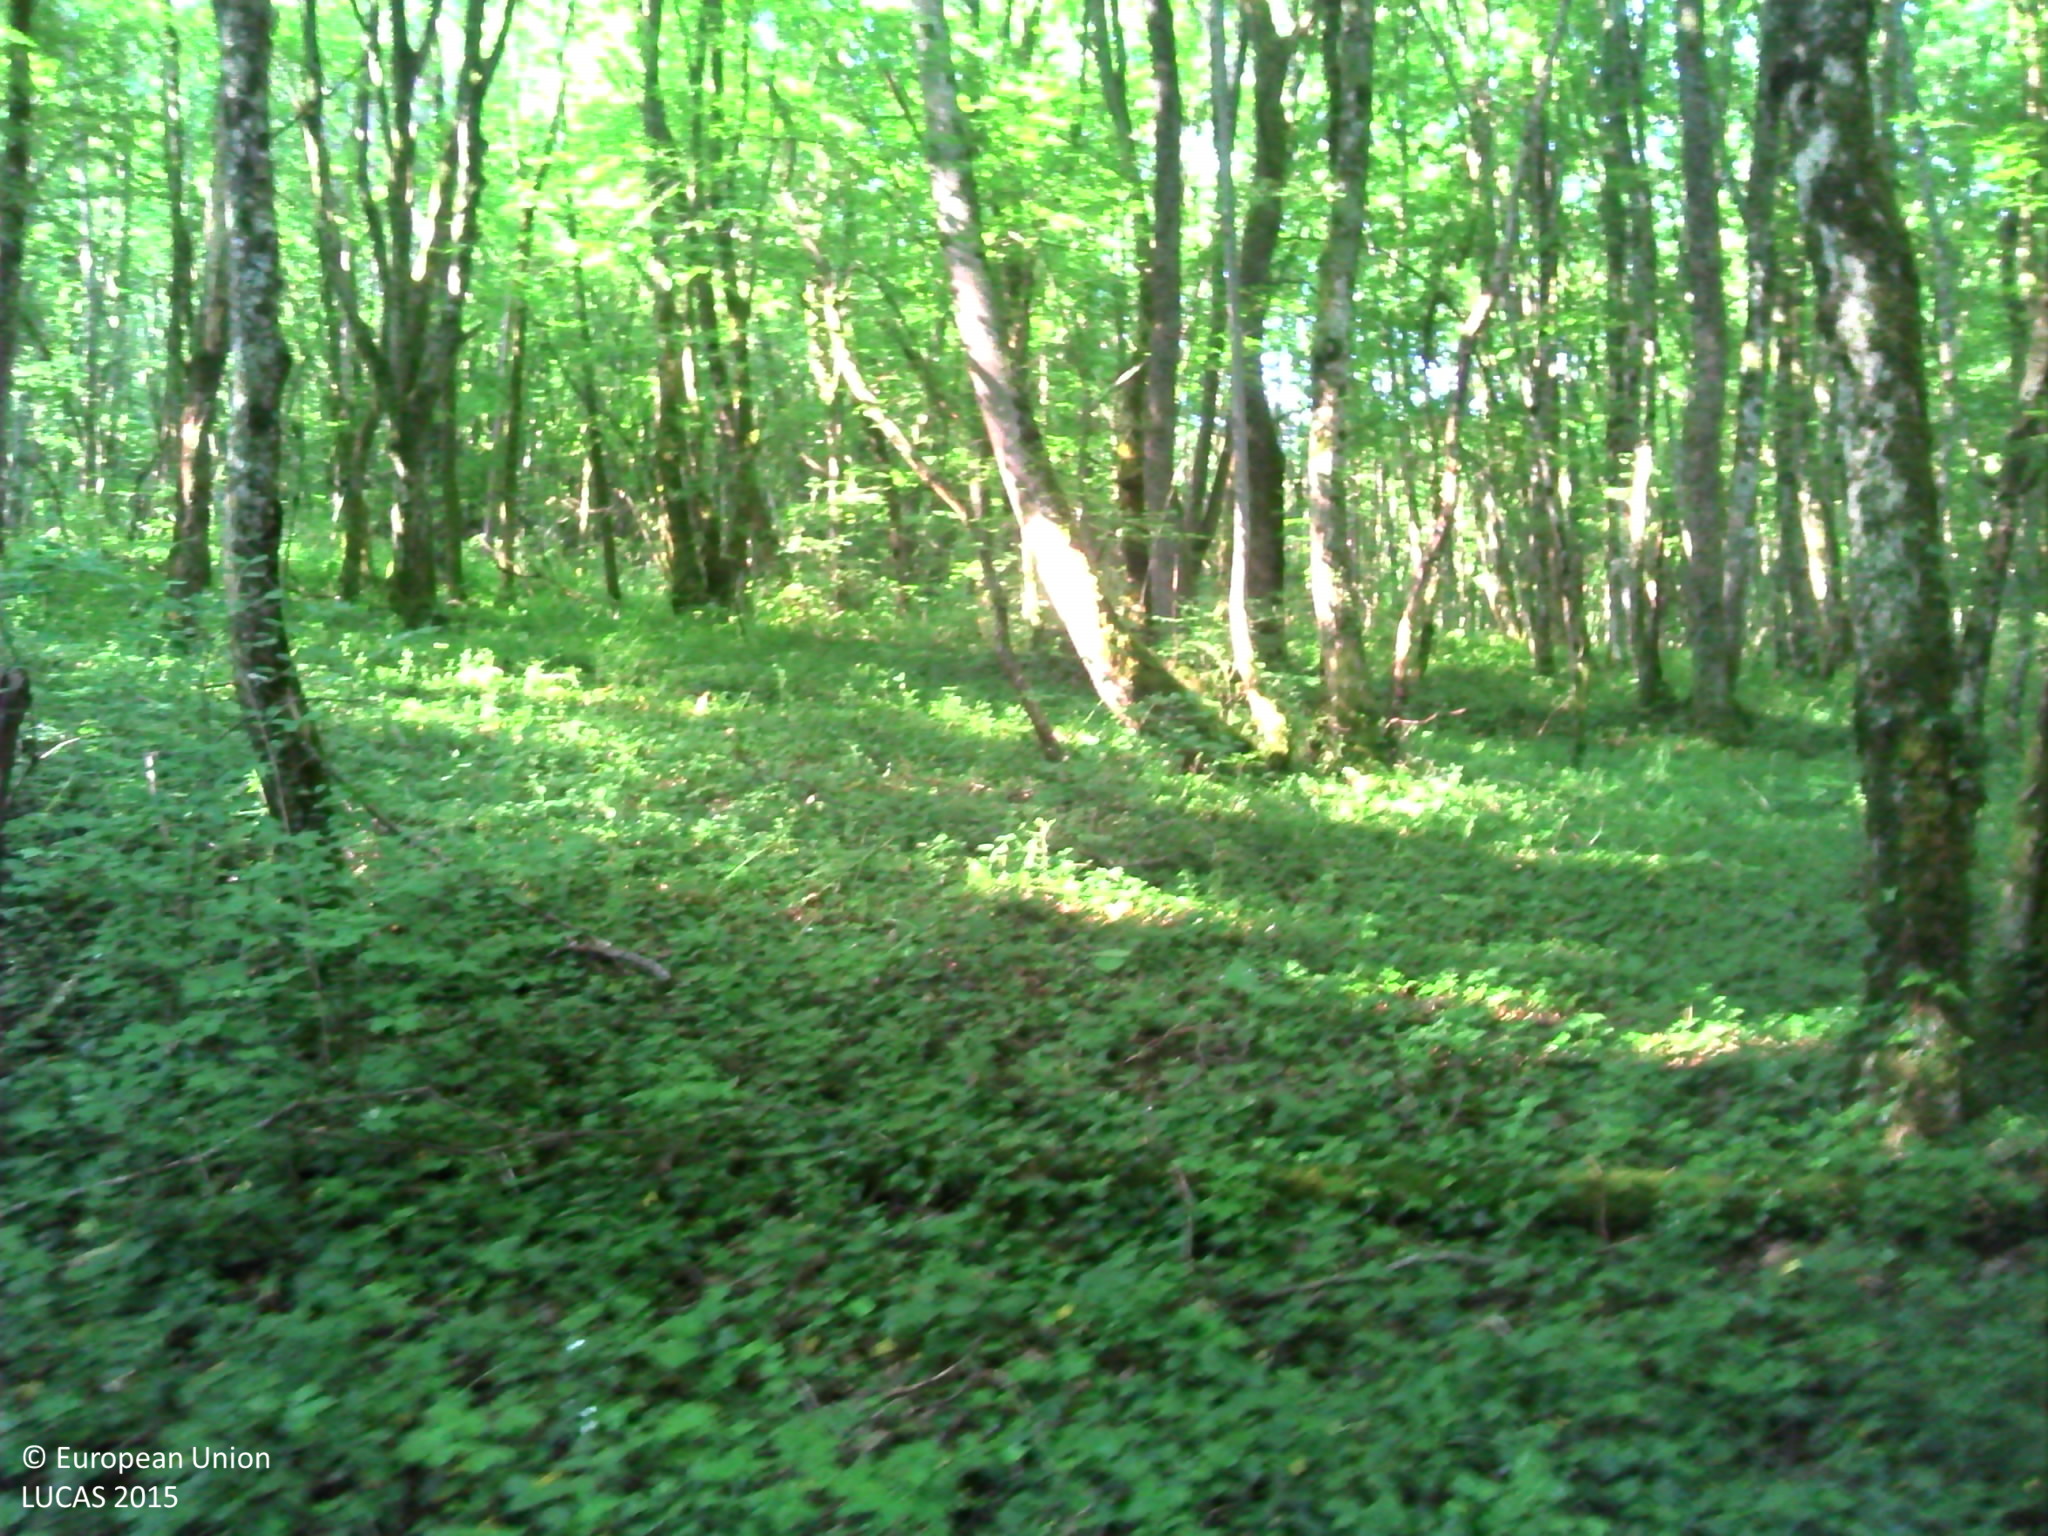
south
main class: Woodland
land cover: Broadleaved woodland
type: beech forest
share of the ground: > 75 %
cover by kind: broadleaved forest trees 95 %, herbaceous plants 5 %
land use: Forestry
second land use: Sport
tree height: > 5 m
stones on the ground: < 10 %
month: June
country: FR
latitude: 47.5981
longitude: 6.1576
